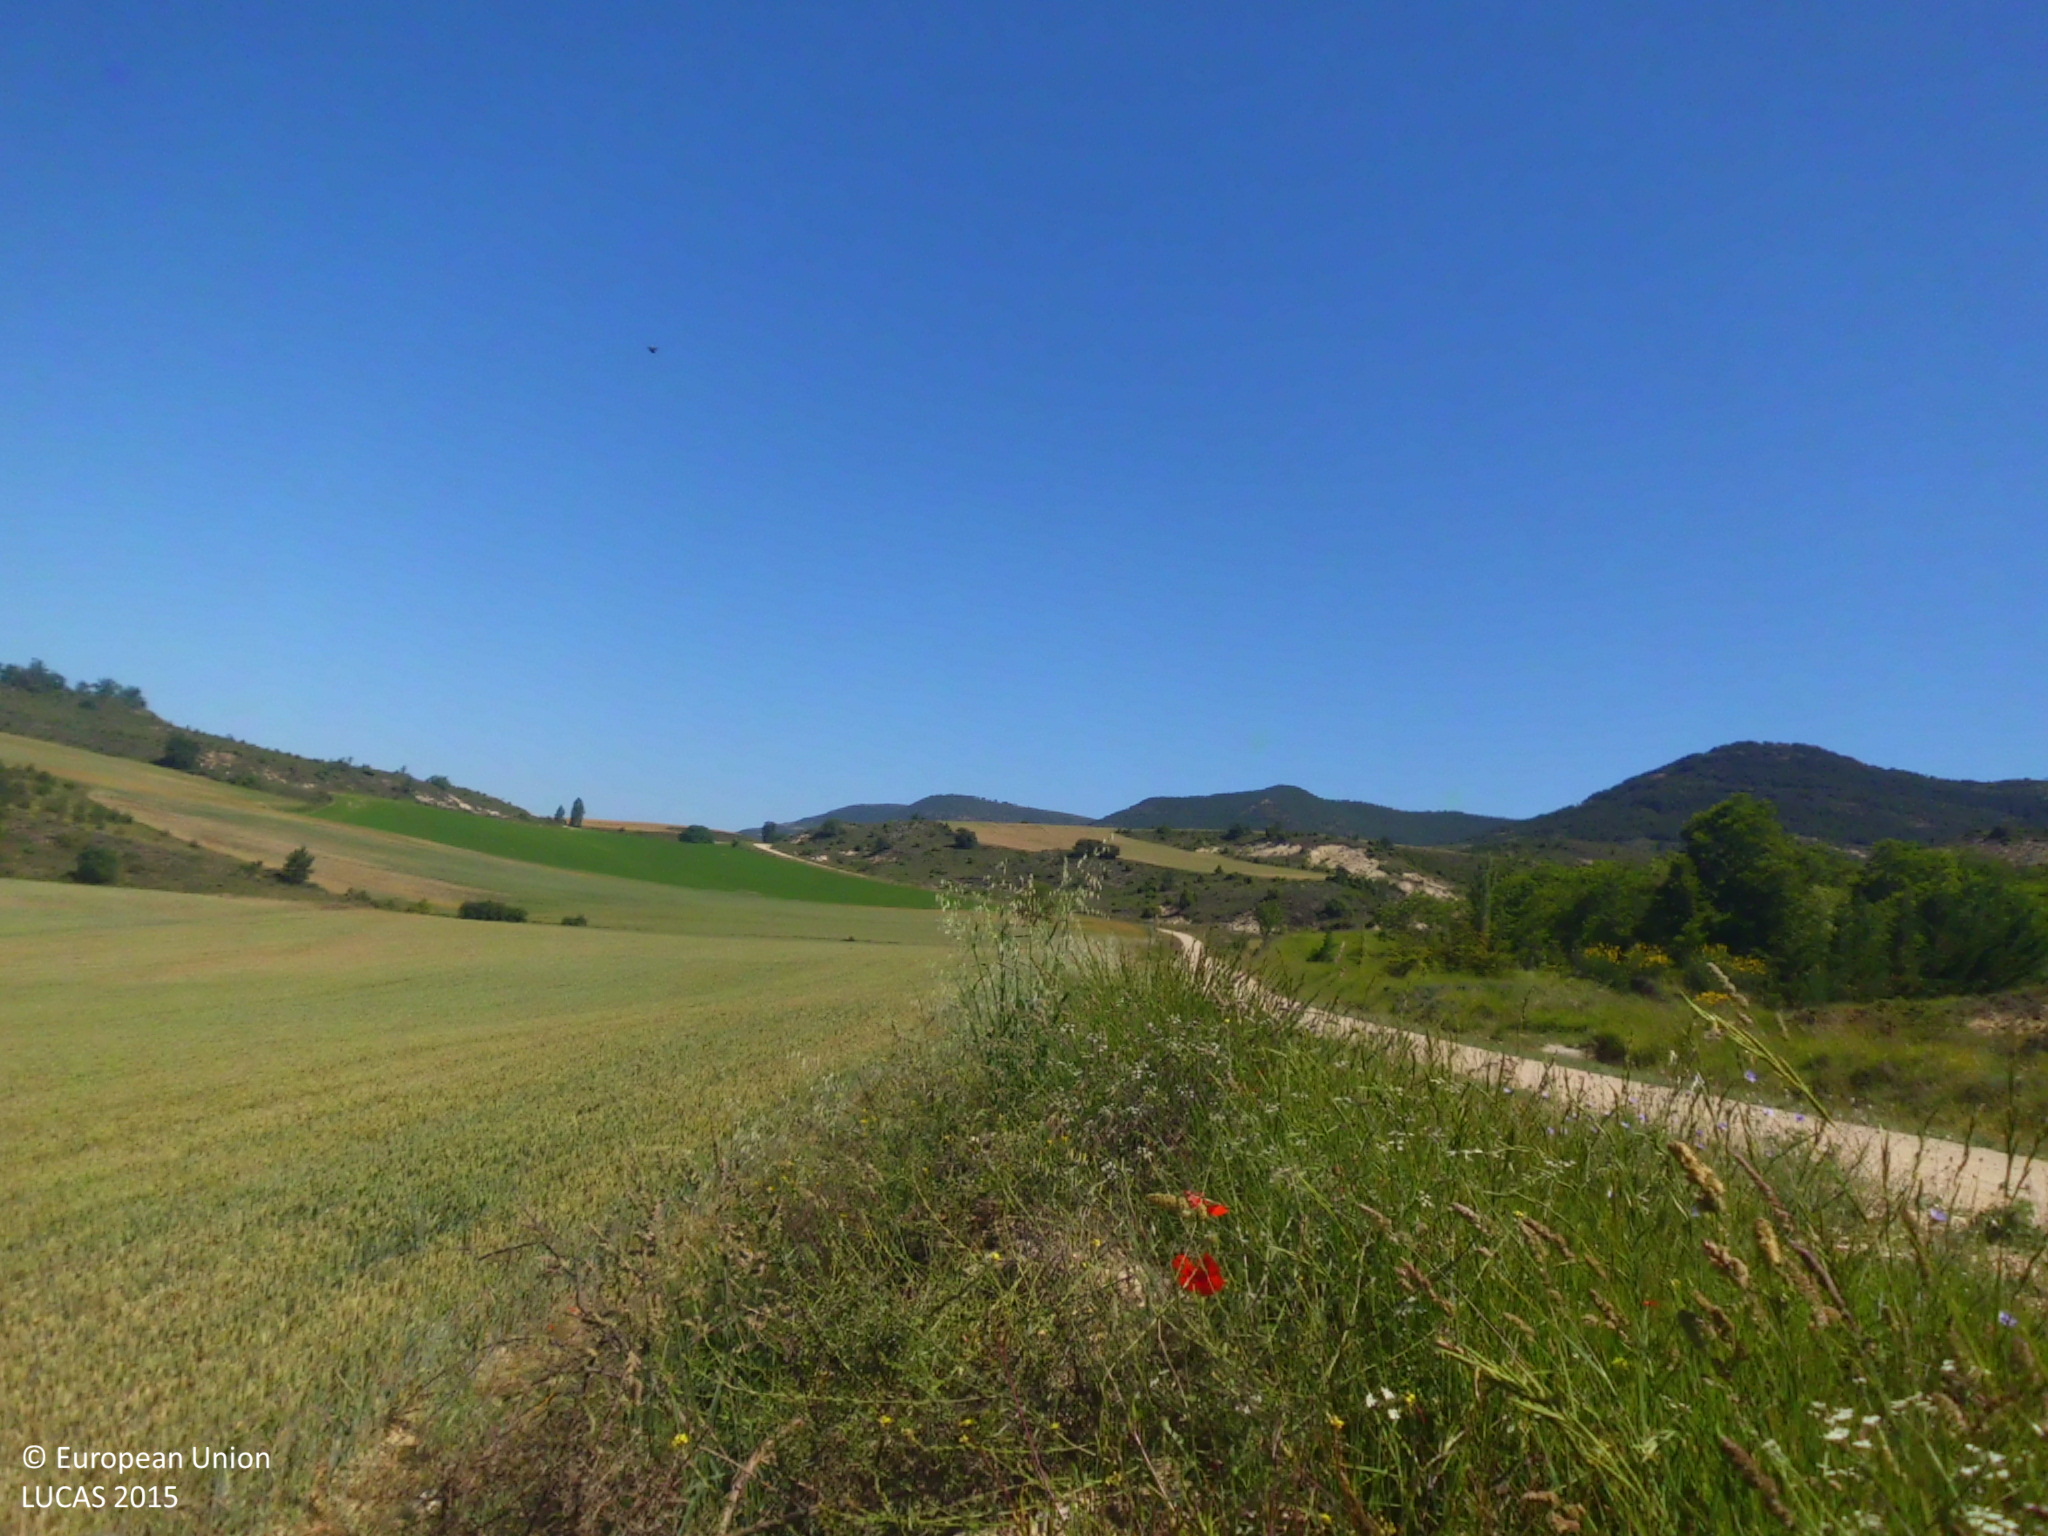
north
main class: Shrubland
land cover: Shrubland without tree cover
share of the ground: > 75 %
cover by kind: shrubs 90 %, herbaceous plants 10 %
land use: Abandoned areas
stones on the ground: > 50 %
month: June
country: ES
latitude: 42.8718
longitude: -3.4171
